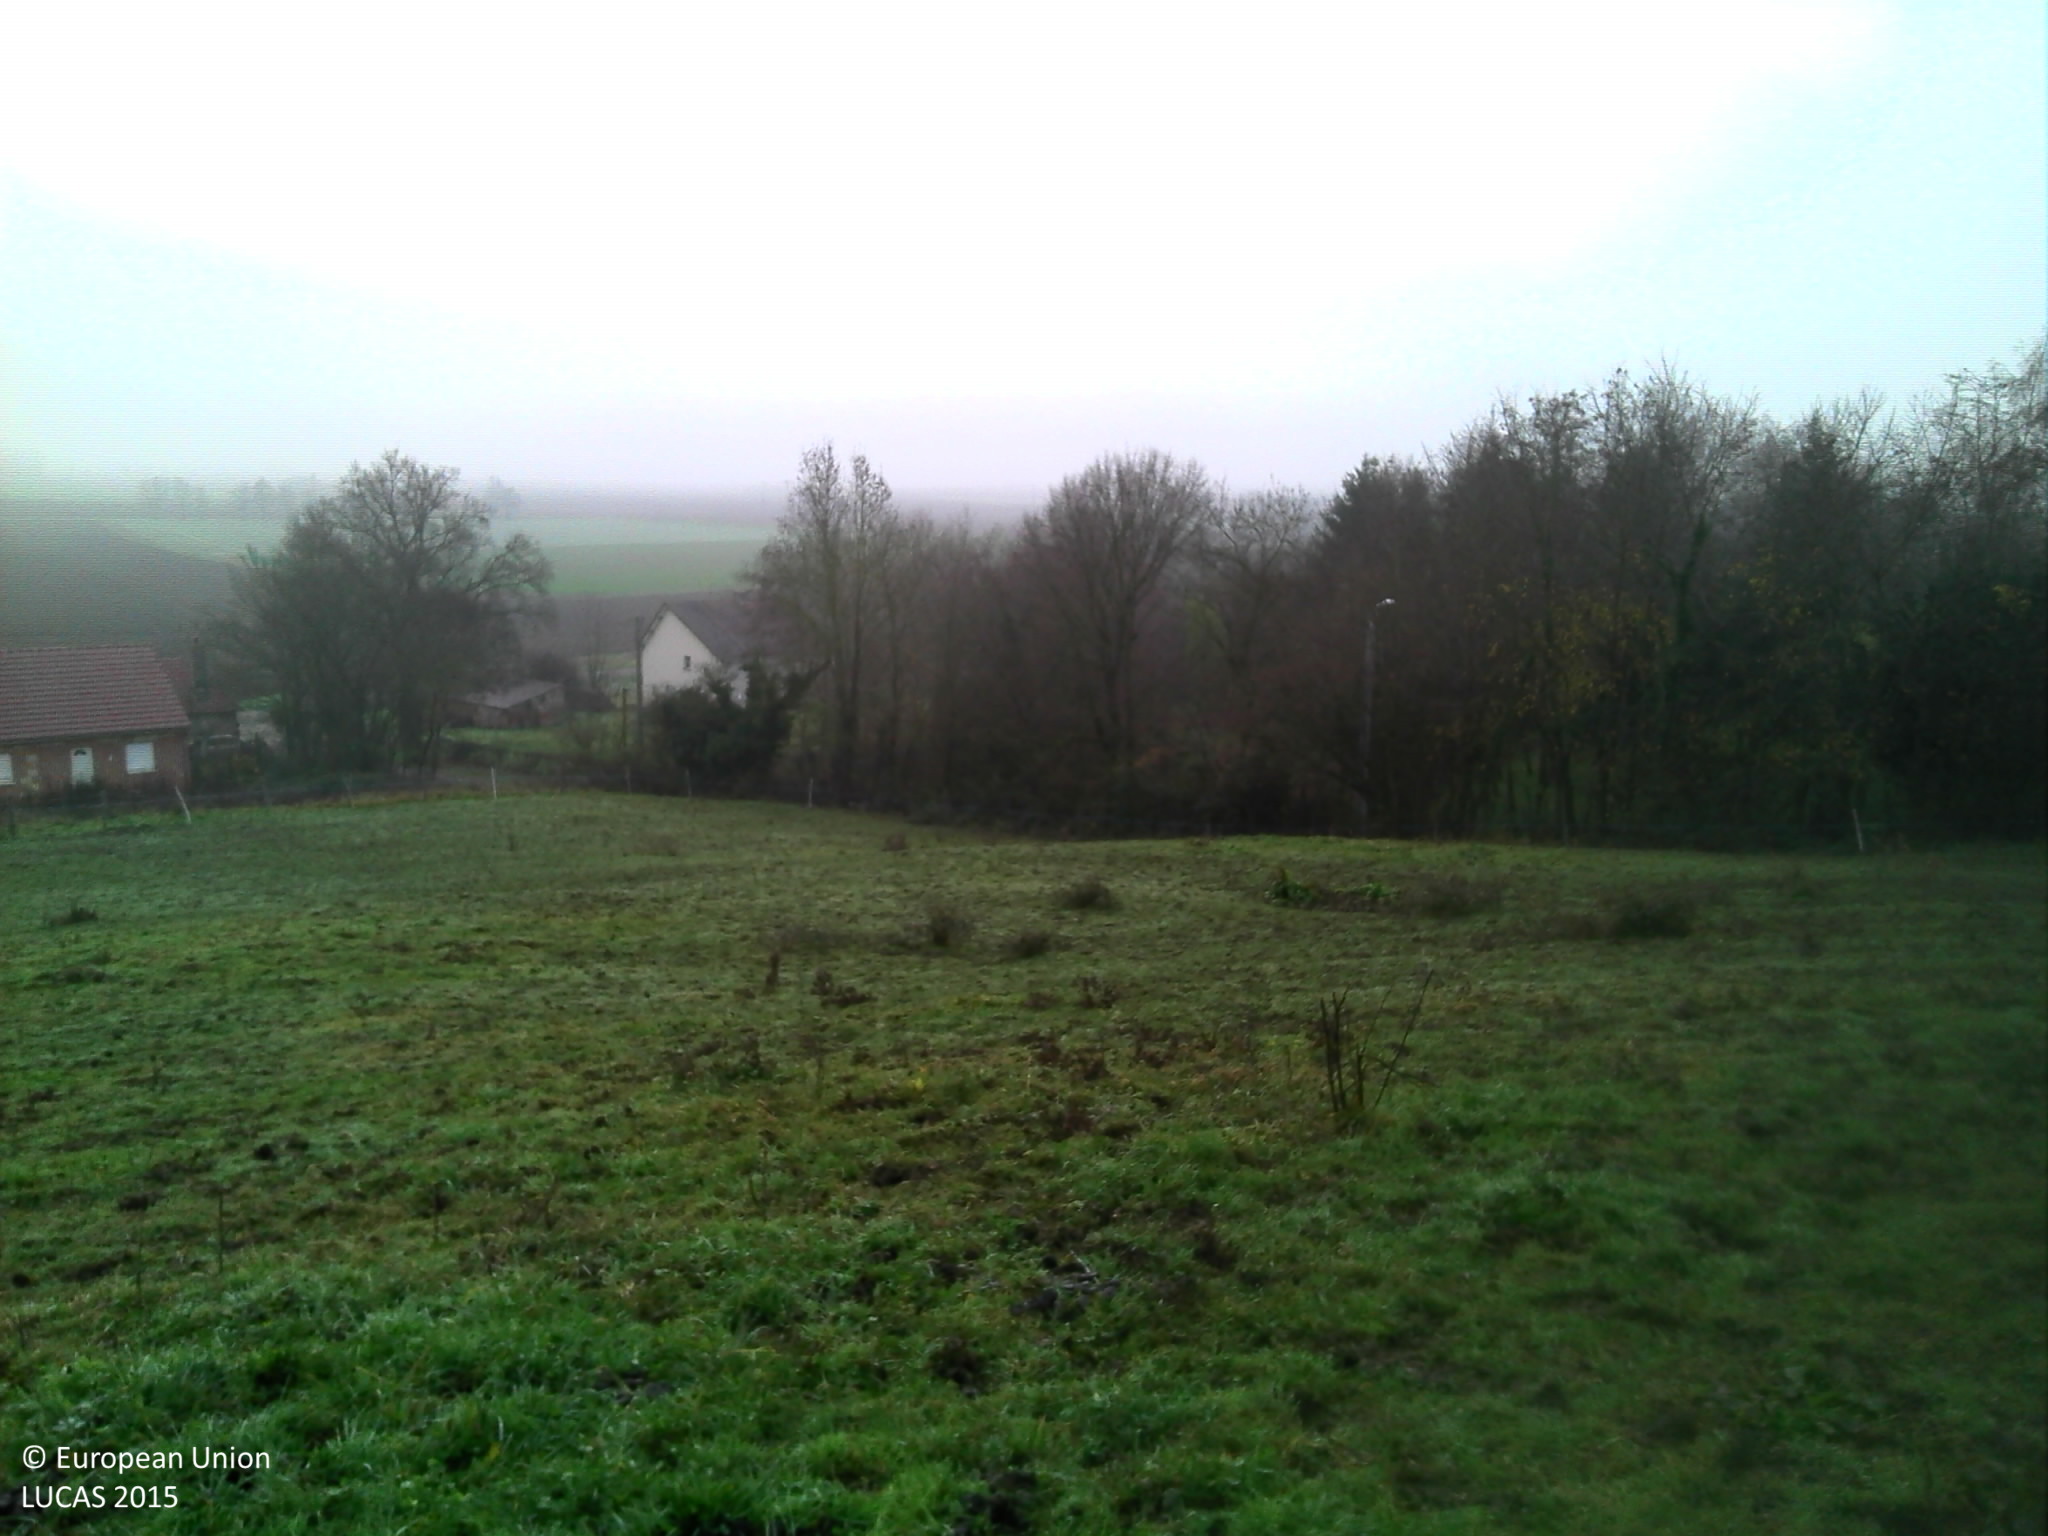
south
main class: Grassland
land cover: Grassland with sparse tree/shrub cover
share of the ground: > 75 %
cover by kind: herbaceous plants 95 %, broadleaved forest trees 5 %
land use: Agriculture (excluding fallow land and kitchen gardens)
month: December
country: FR
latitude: 46.9965
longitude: 5.0962
